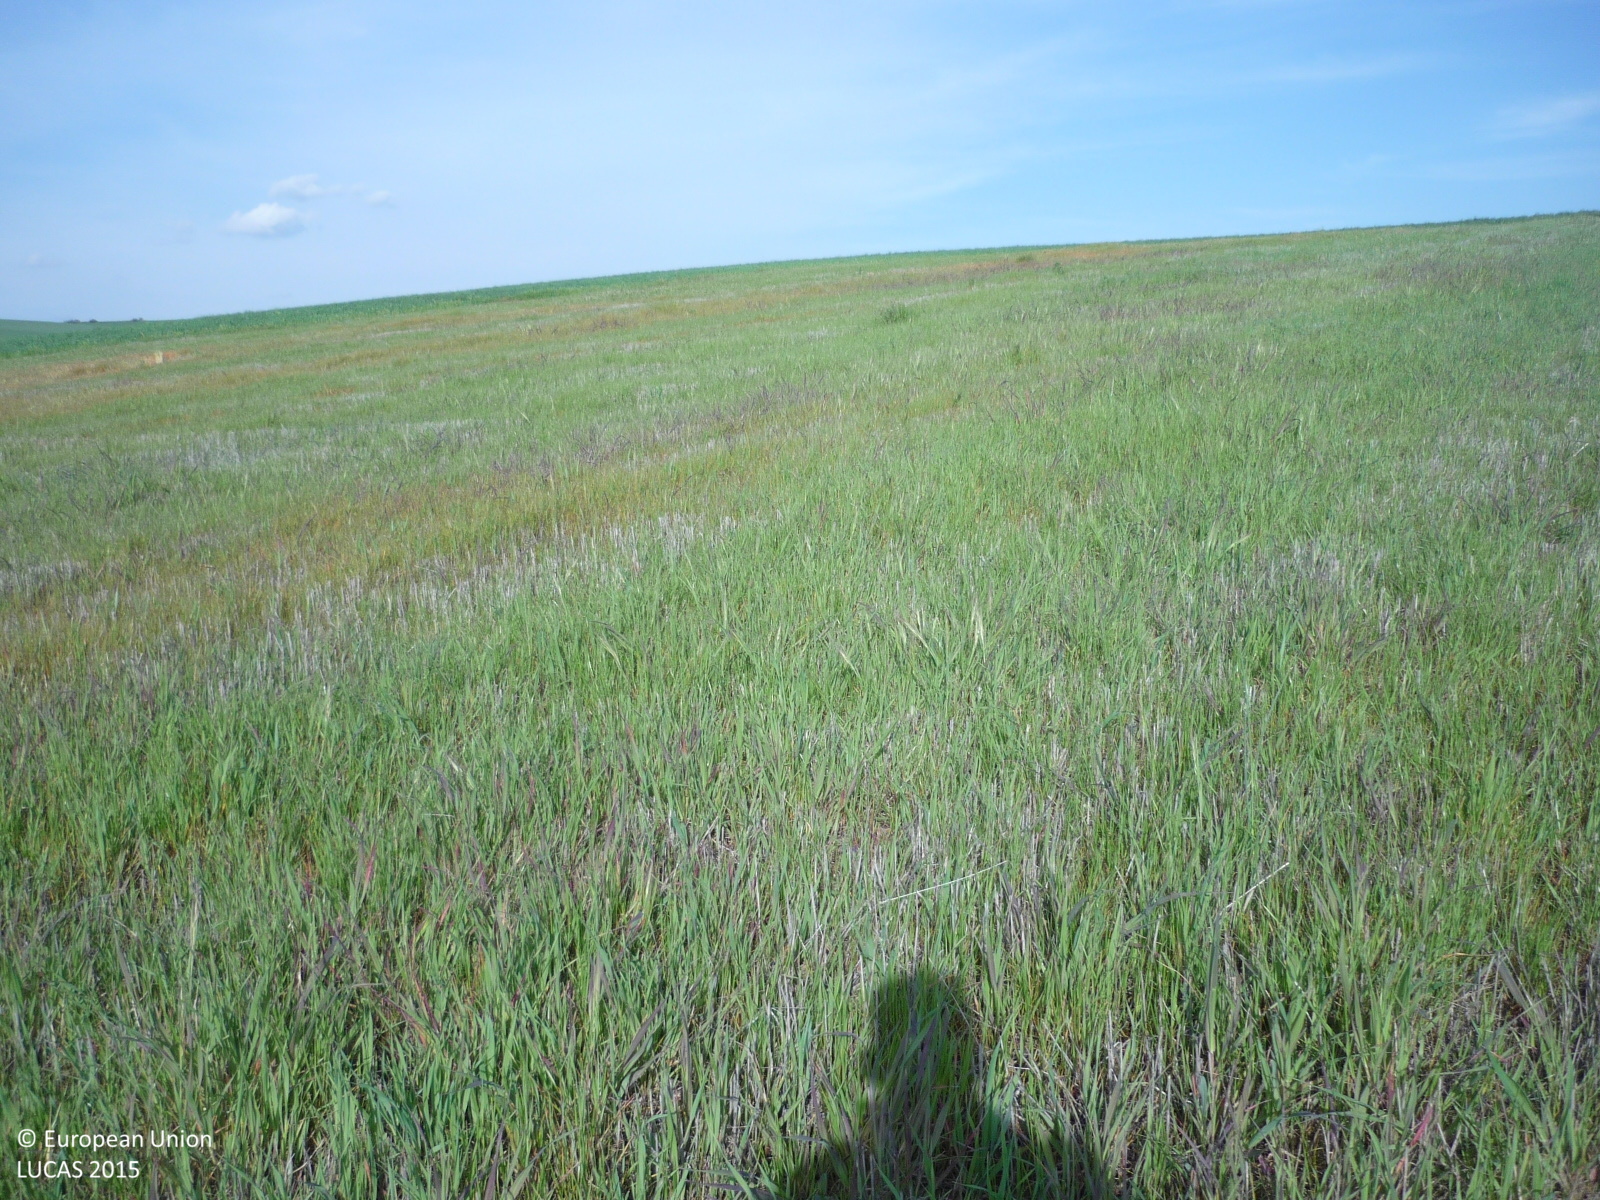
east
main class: Grassland
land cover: Spontaneously vegetated surfaces
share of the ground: > 75 %
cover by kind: herbaceous plants 90 %, unconsolidated bare surface 10 %
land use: Fallow land
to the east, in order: Spontaneously vegetated surfaces; Common wheat; Grass margins; Common wheat; Grass margins; Tracks; Grass margins; Common wheat
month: April
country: ES
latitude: 40.7600
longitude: -3.4838
